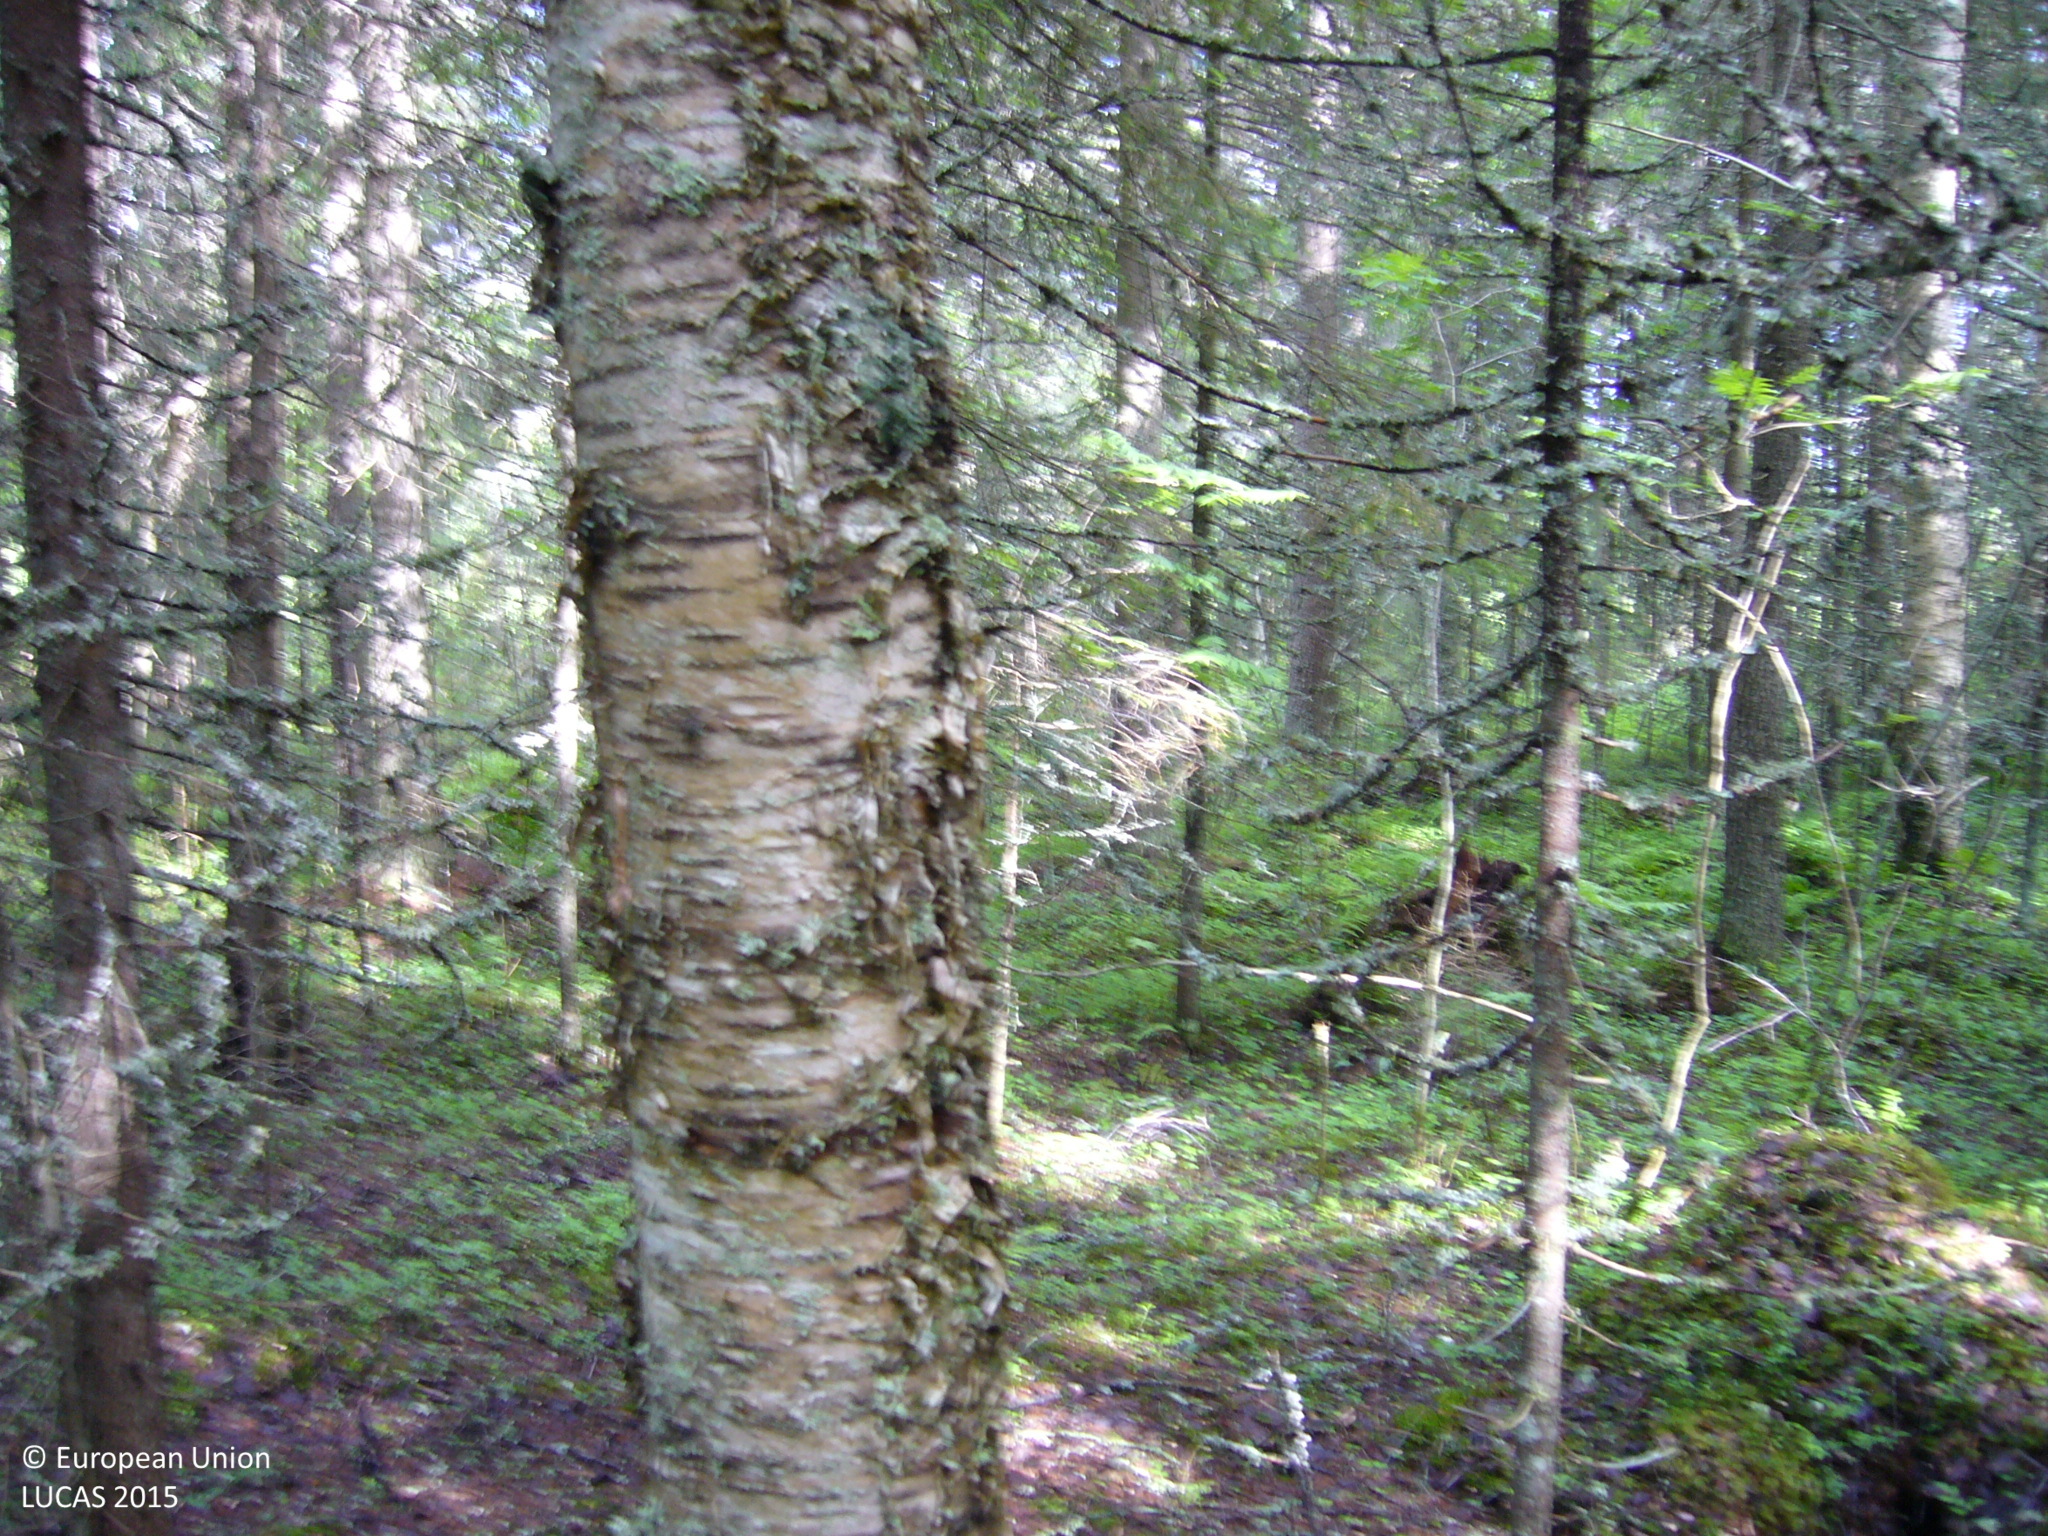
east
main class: Woodland
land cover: Spruce dominated coniferous woodland
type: boreal forest
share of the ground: > 75 %
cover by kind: coniferous forest trees 85 %, broadleaved forest trees 10 %, shrubs 5 %
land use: Forestry
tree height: > 5 m
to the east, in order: Spruce dominated coniferous woodland; Ditches and canals; Spruce dominated coniferous woodland; Ditches and canals; Temporary grasslands; Ditches and canals; Spruce dominated mixed woodland; Ditches and canals; Spruce dominated mixed woodland; Spruce dominated coniferous woodland; Ditches and canals; Spruce dominated coniferous woodland; Spruce dominated mixed woodland; Ditches and canals; Spruce dominated mixed woodland
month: June
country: FI
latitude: 63.7493
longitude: 26.3100
